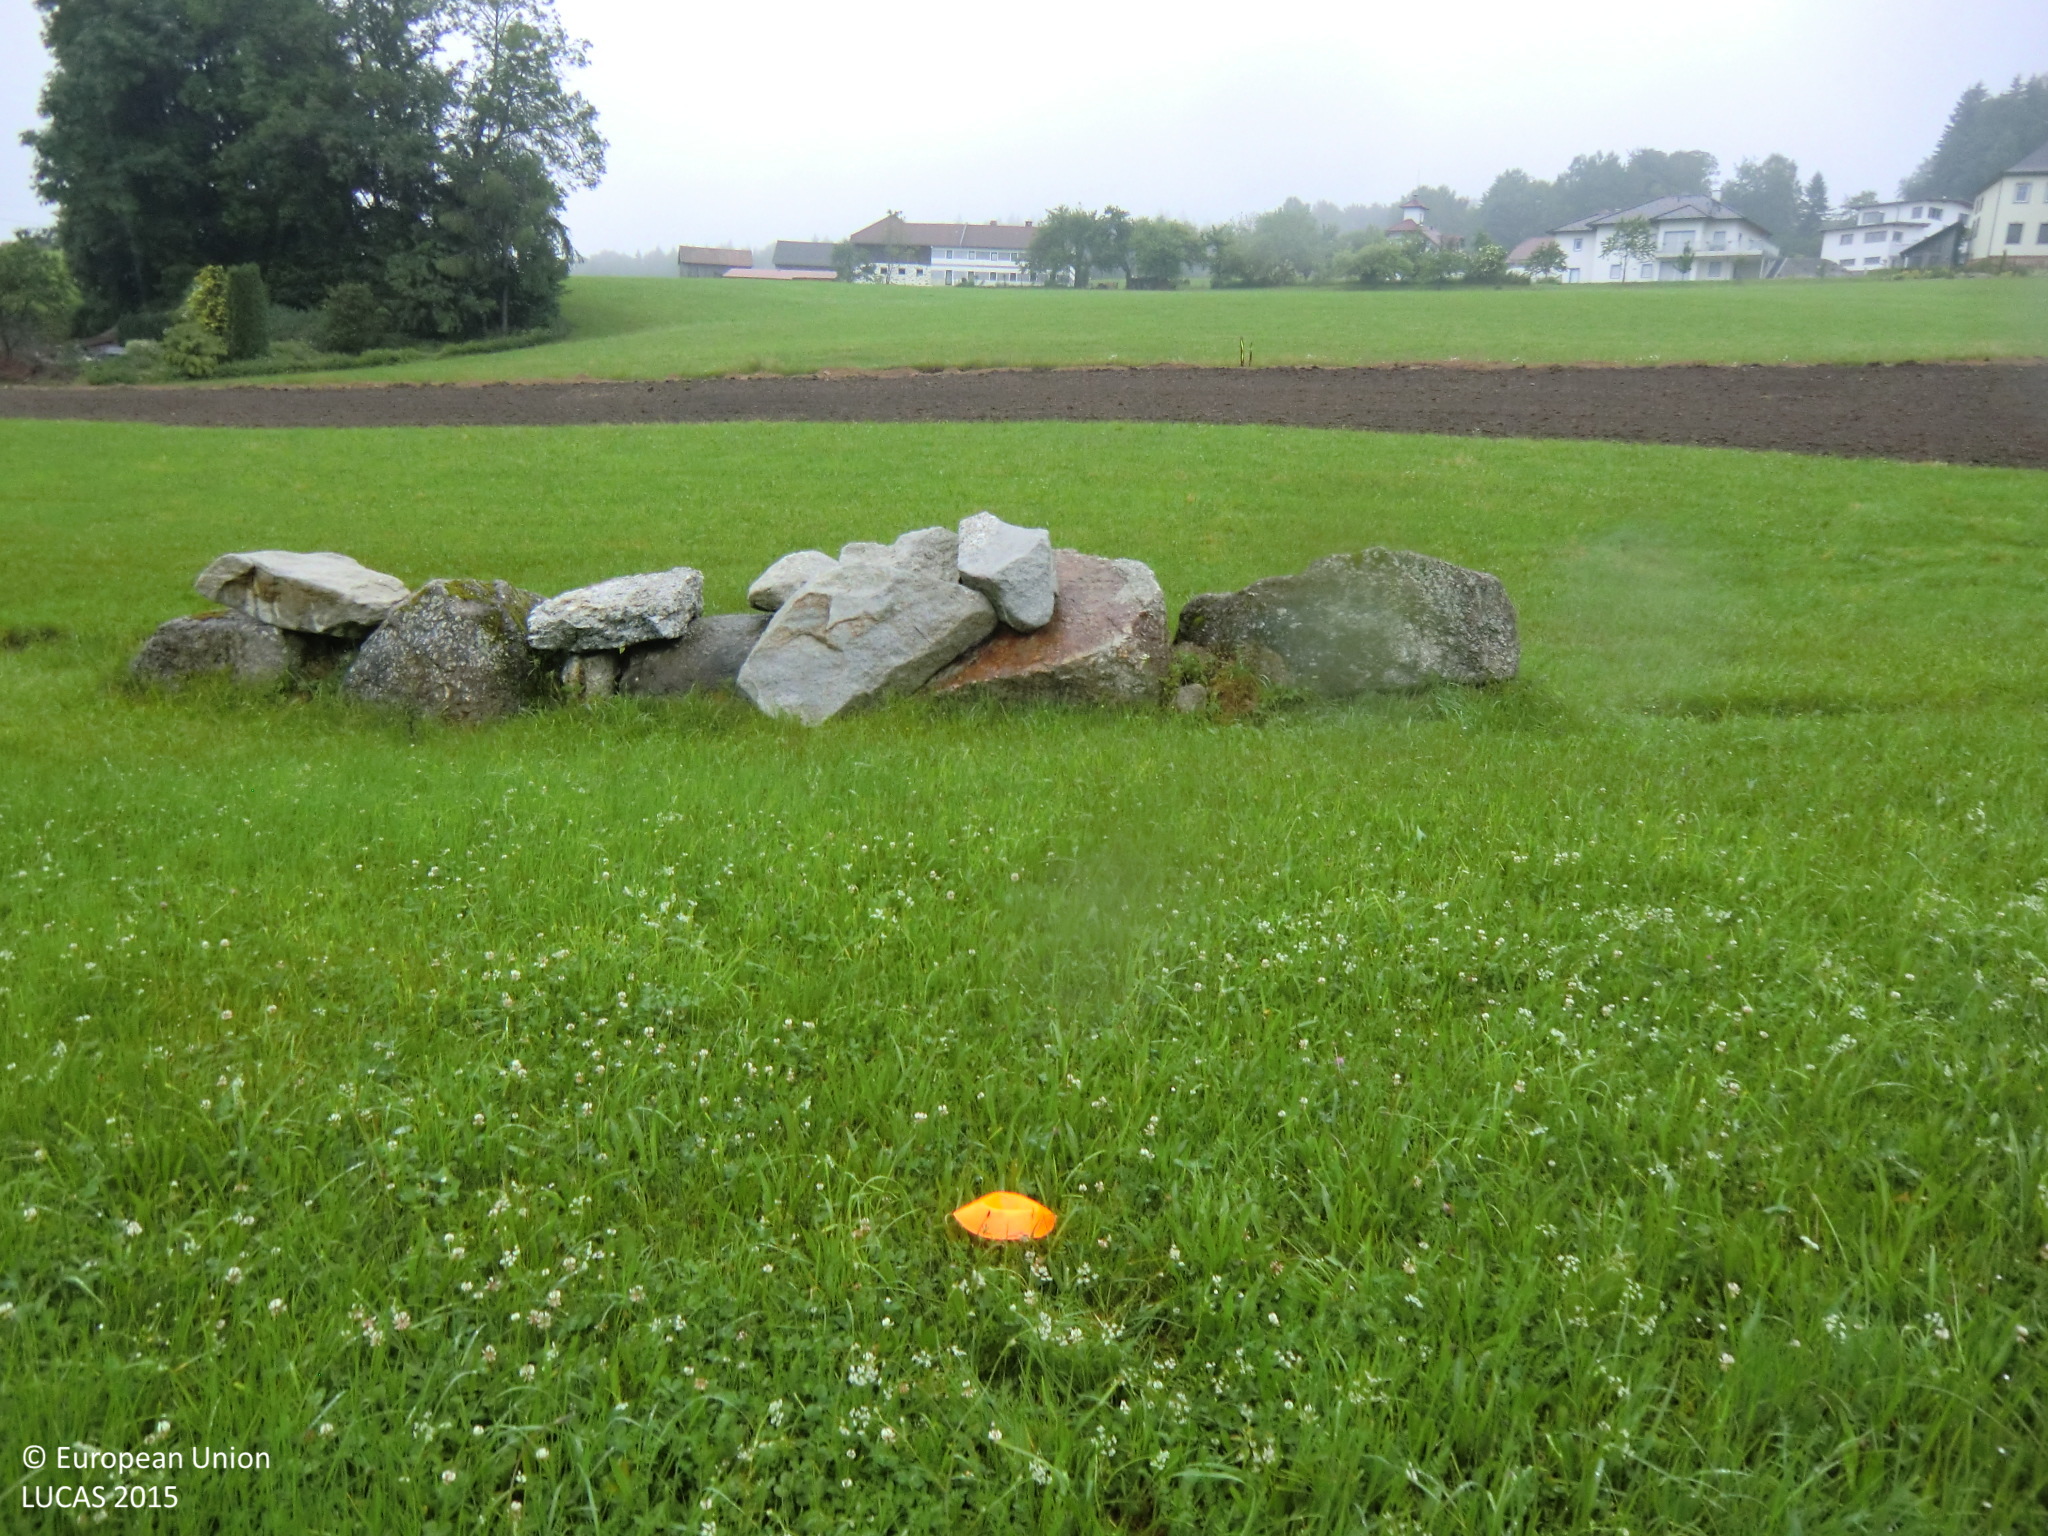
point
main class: Grassland
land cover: Grassland without tree/shrub cover
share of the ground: > 75 %
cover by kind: herbaceous plants 100 %
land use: Agriculture (excluding fallow land and kitchen gardens)
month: June
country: AT
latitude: 48.6142
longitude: 14.5992
